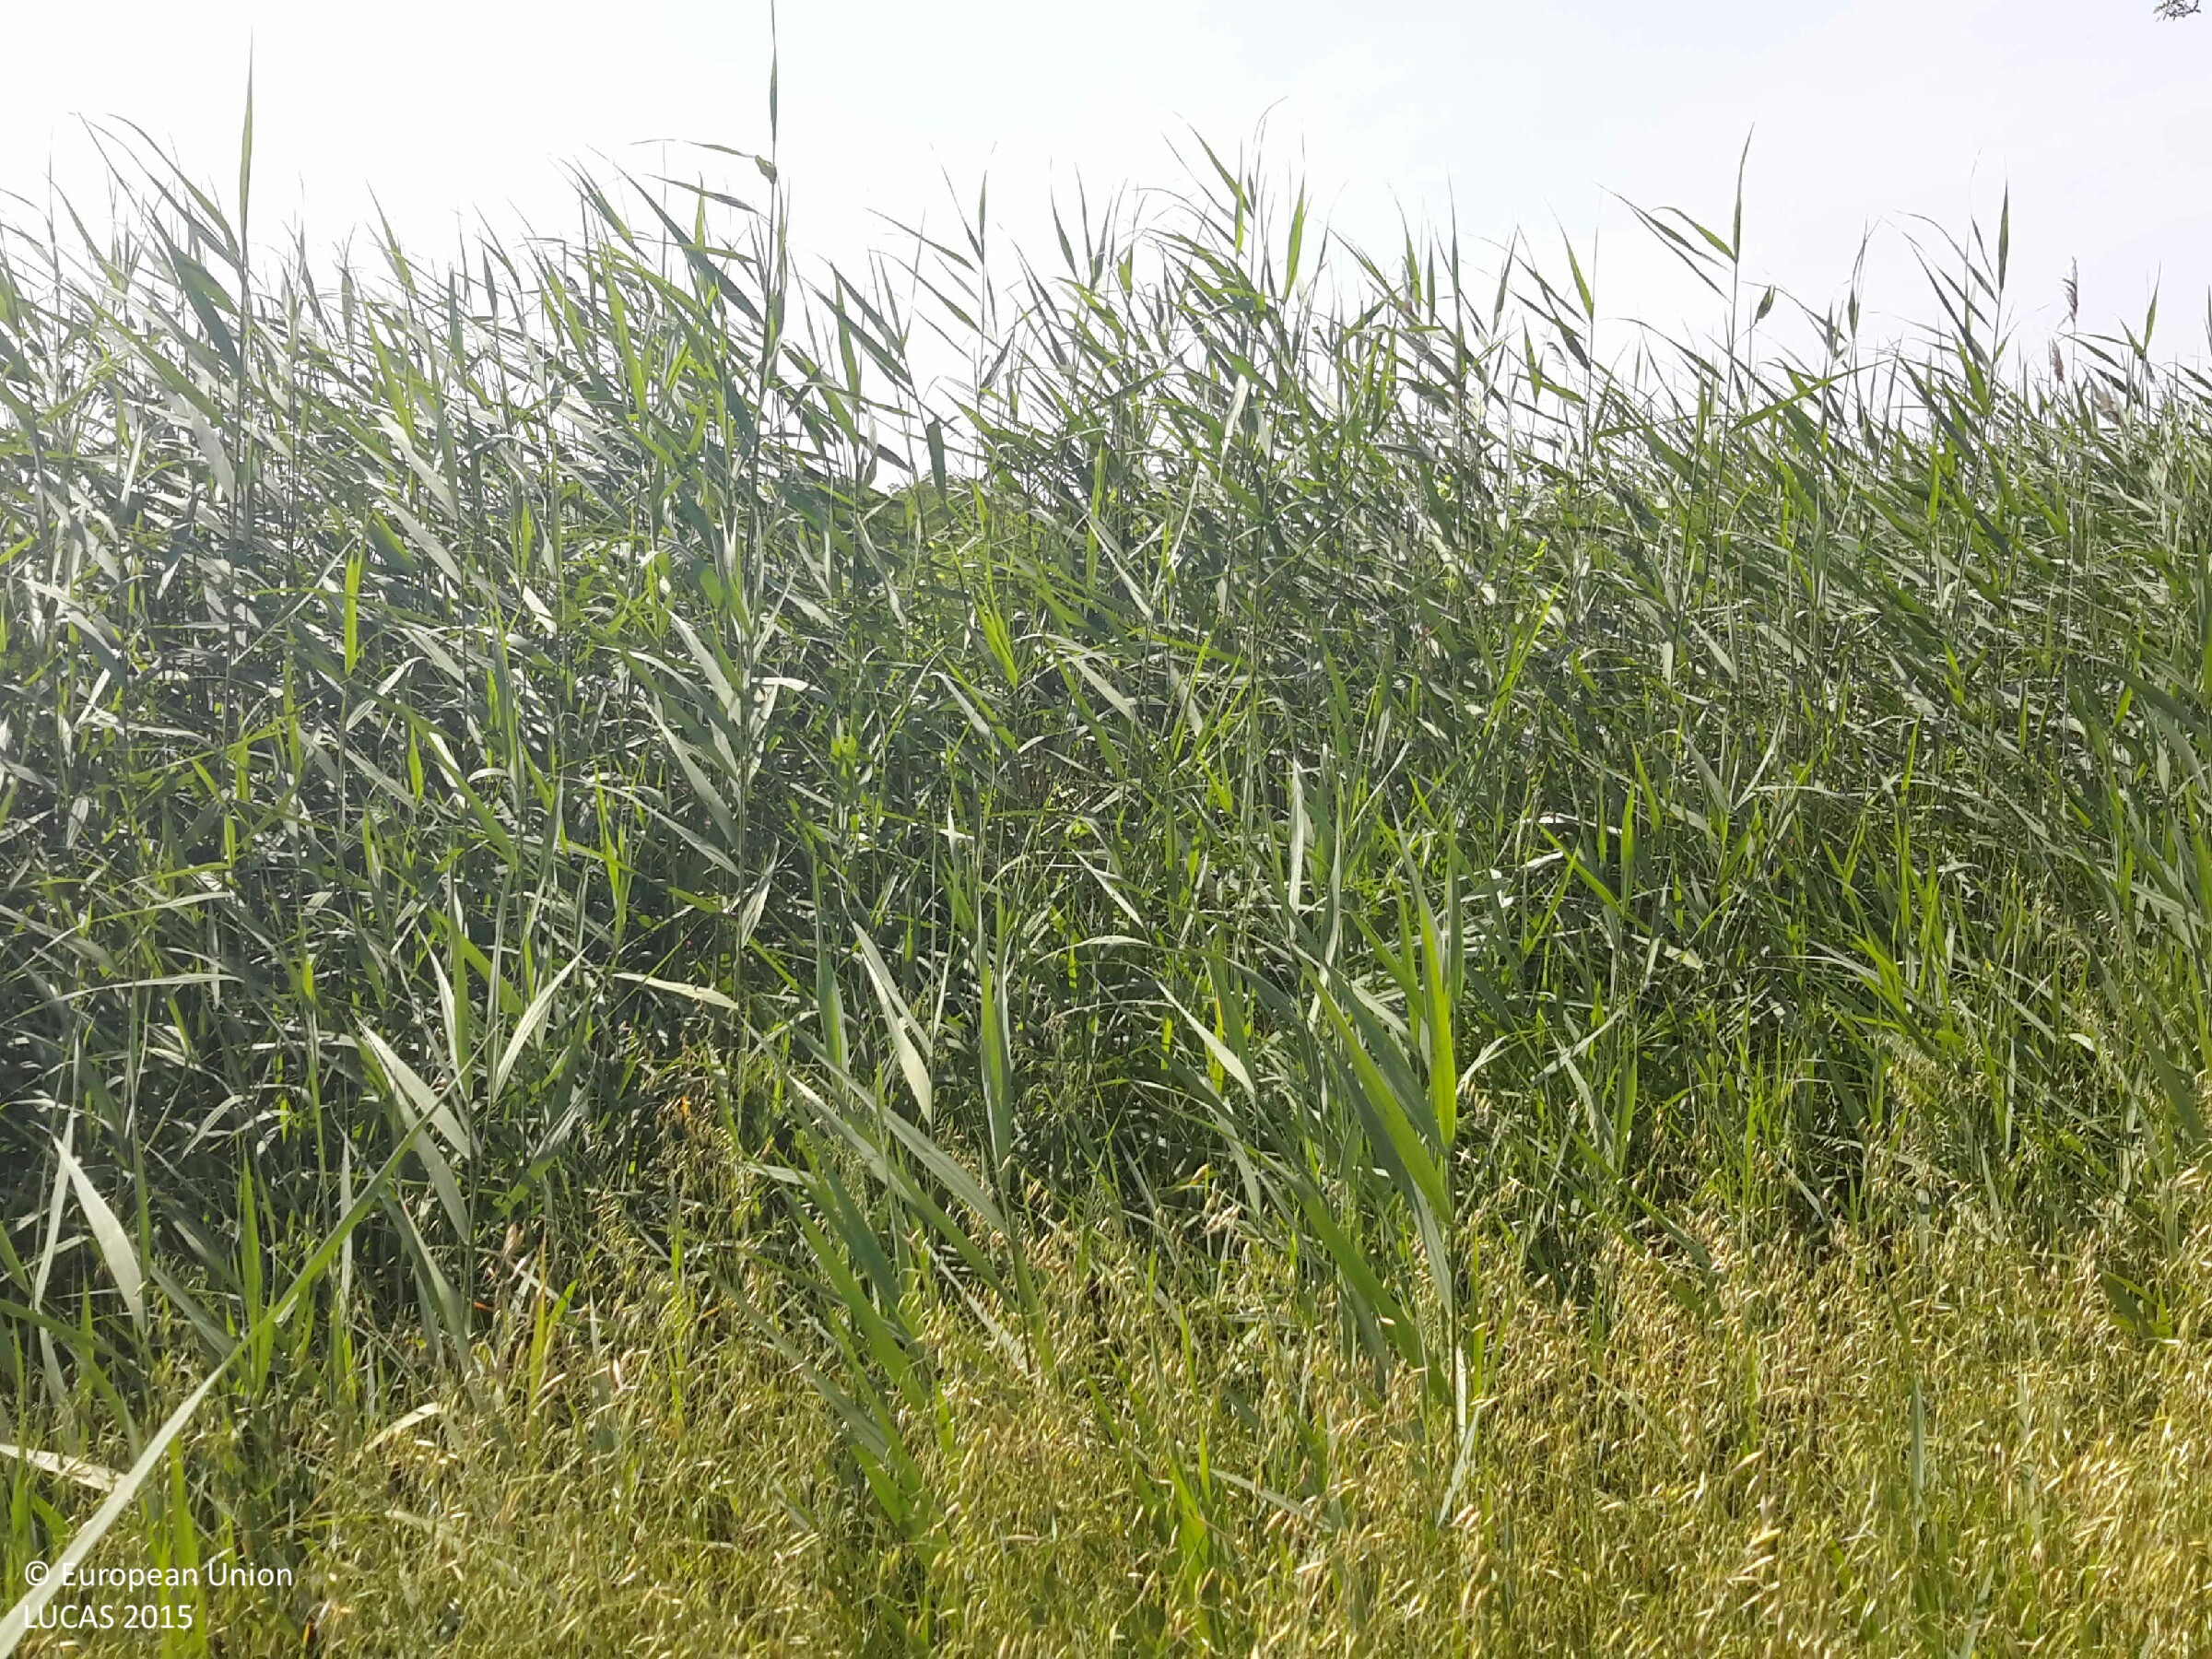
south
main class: Cropland
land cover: Oats
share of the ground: > 75 %
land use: Agriculture (excluding fallow land and kitchen gardens)
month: July
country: HU
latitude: 47.4079
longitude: 17.4952
